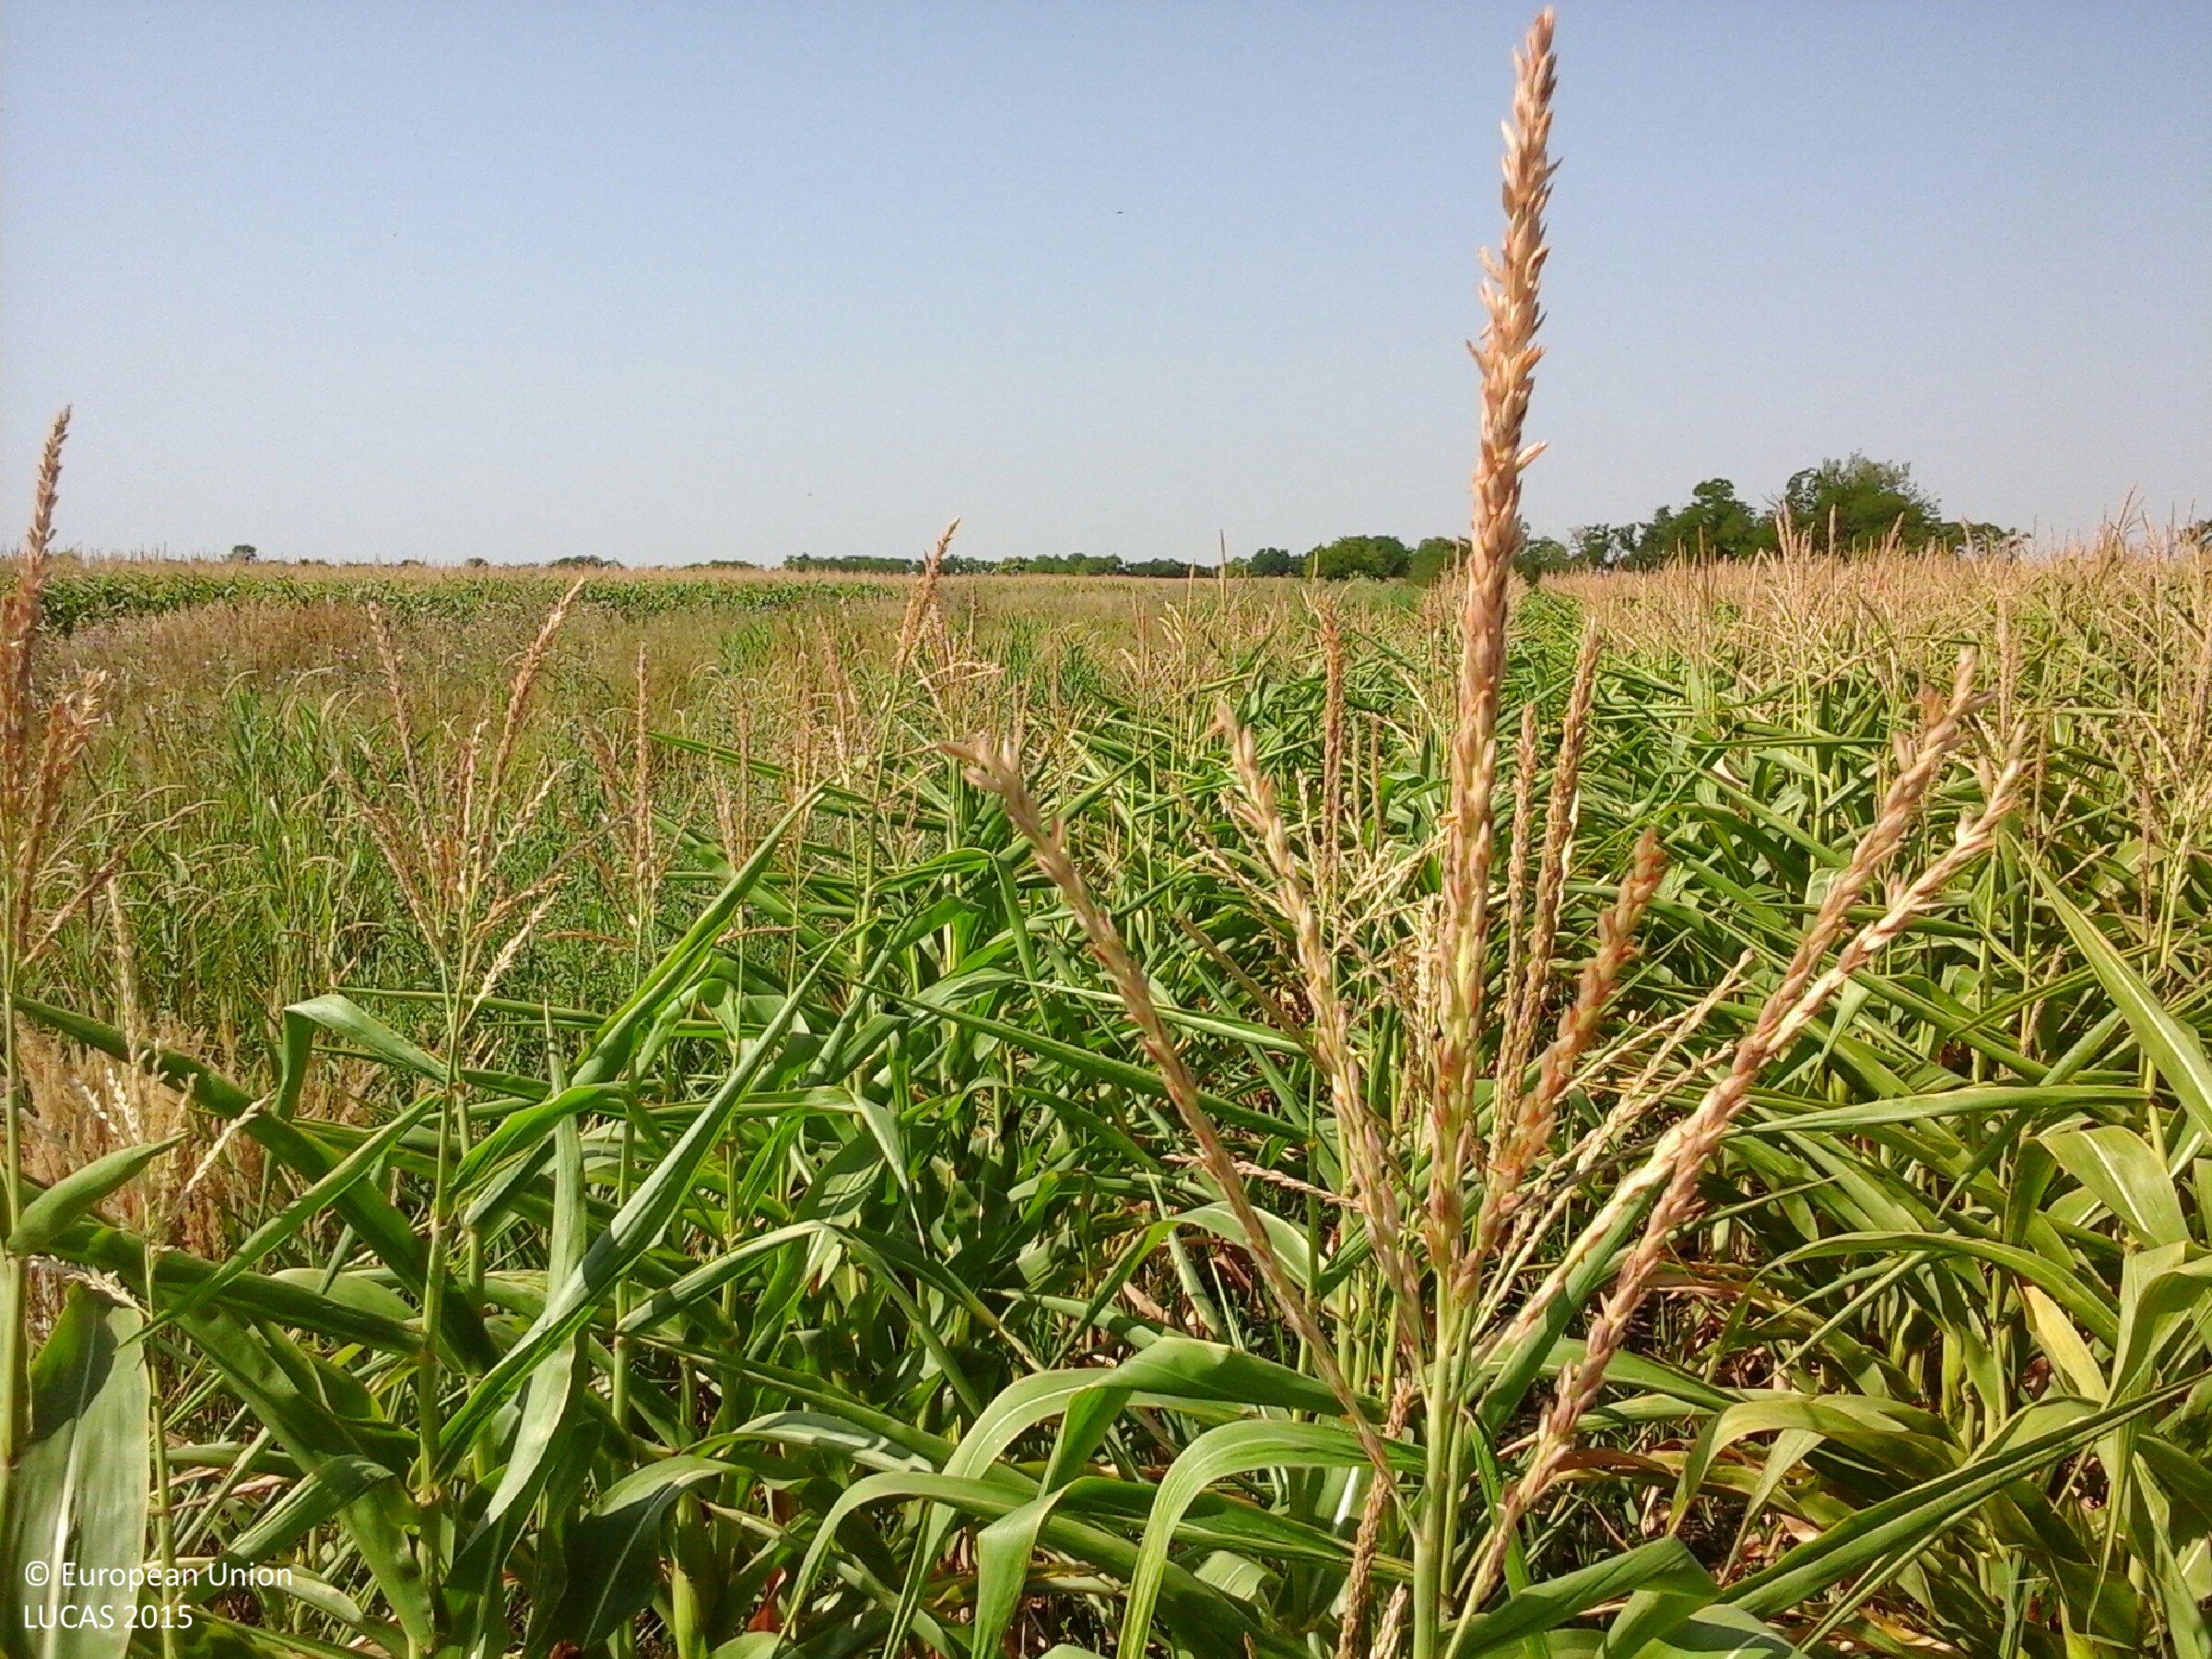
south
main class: Cropland
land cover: Maize
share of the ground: > 75 %
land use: Agriculture (excluding fallow land and kitchen gardens)
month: July
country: HU
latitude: 47.6422
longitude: 20.5614
